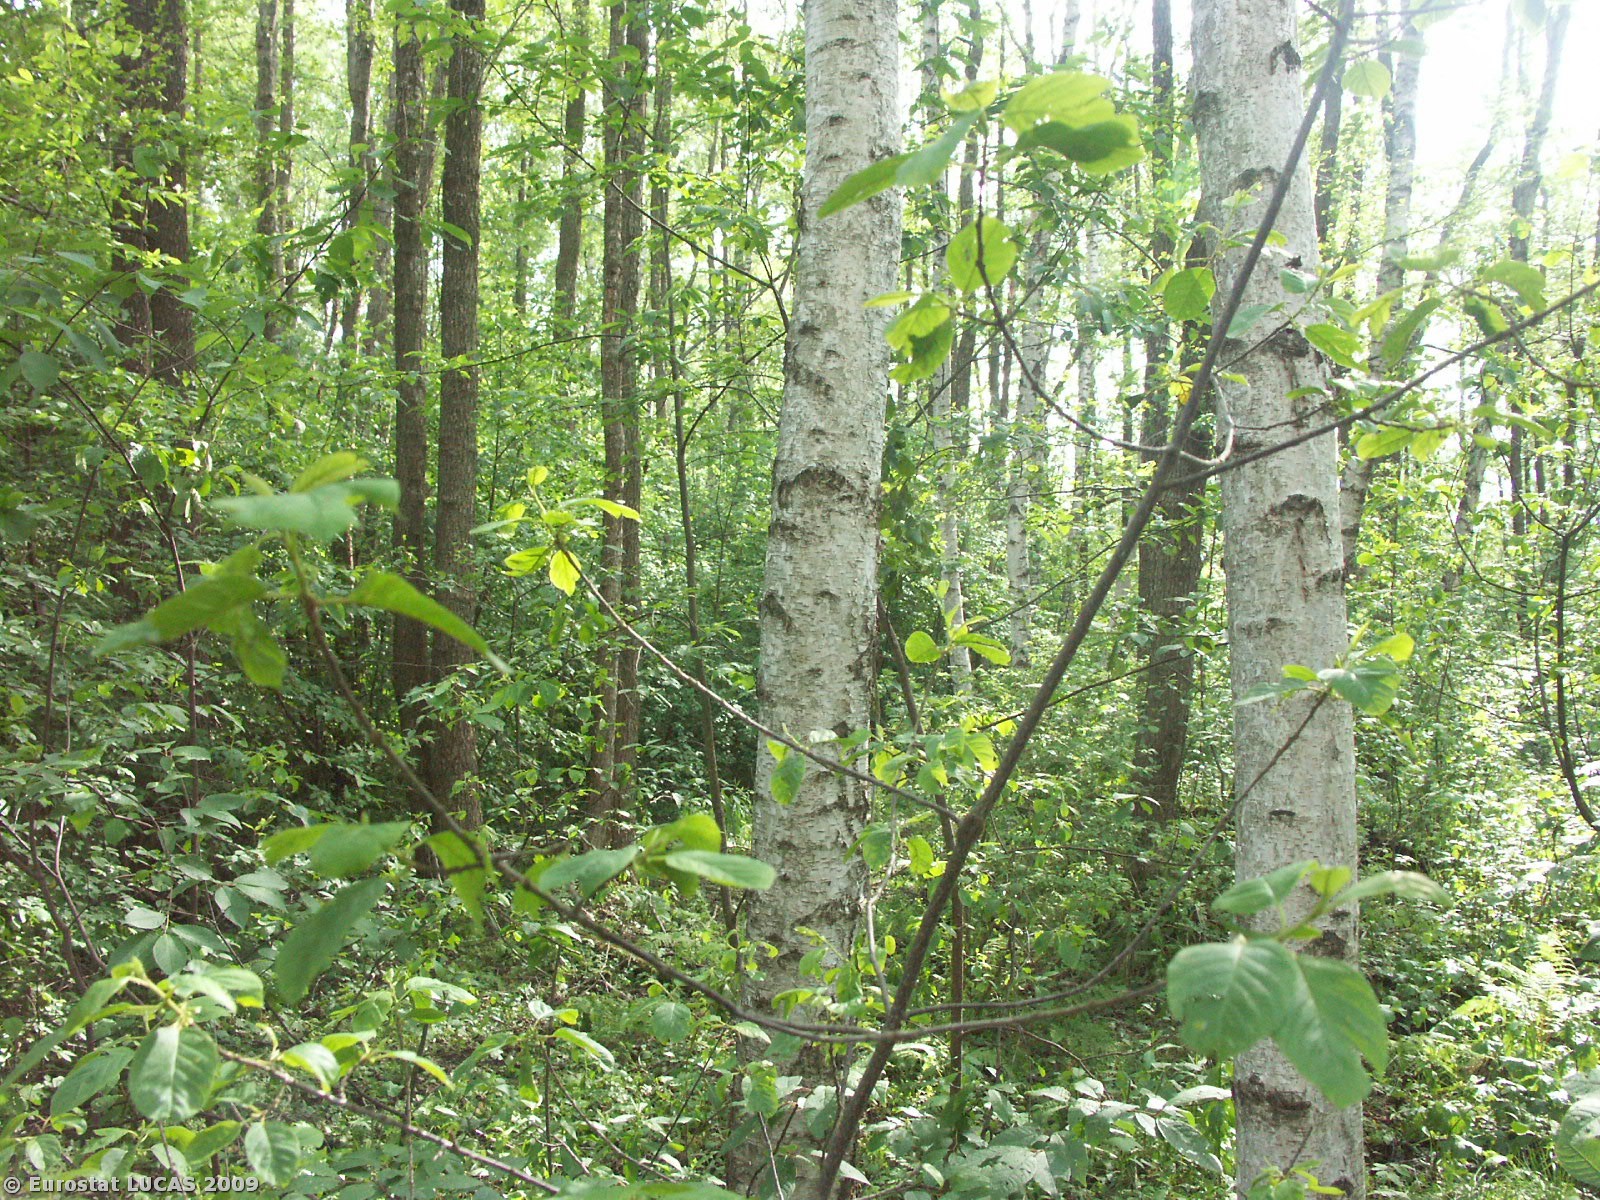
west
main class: Woodland
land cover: Broadleaved woodland
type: non-riverine alder, birch or aspen forest
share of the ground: > 75 %
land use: Forestry
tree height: > 5 m
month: May
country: CZ
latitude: 48.9396
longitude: 14.1099
